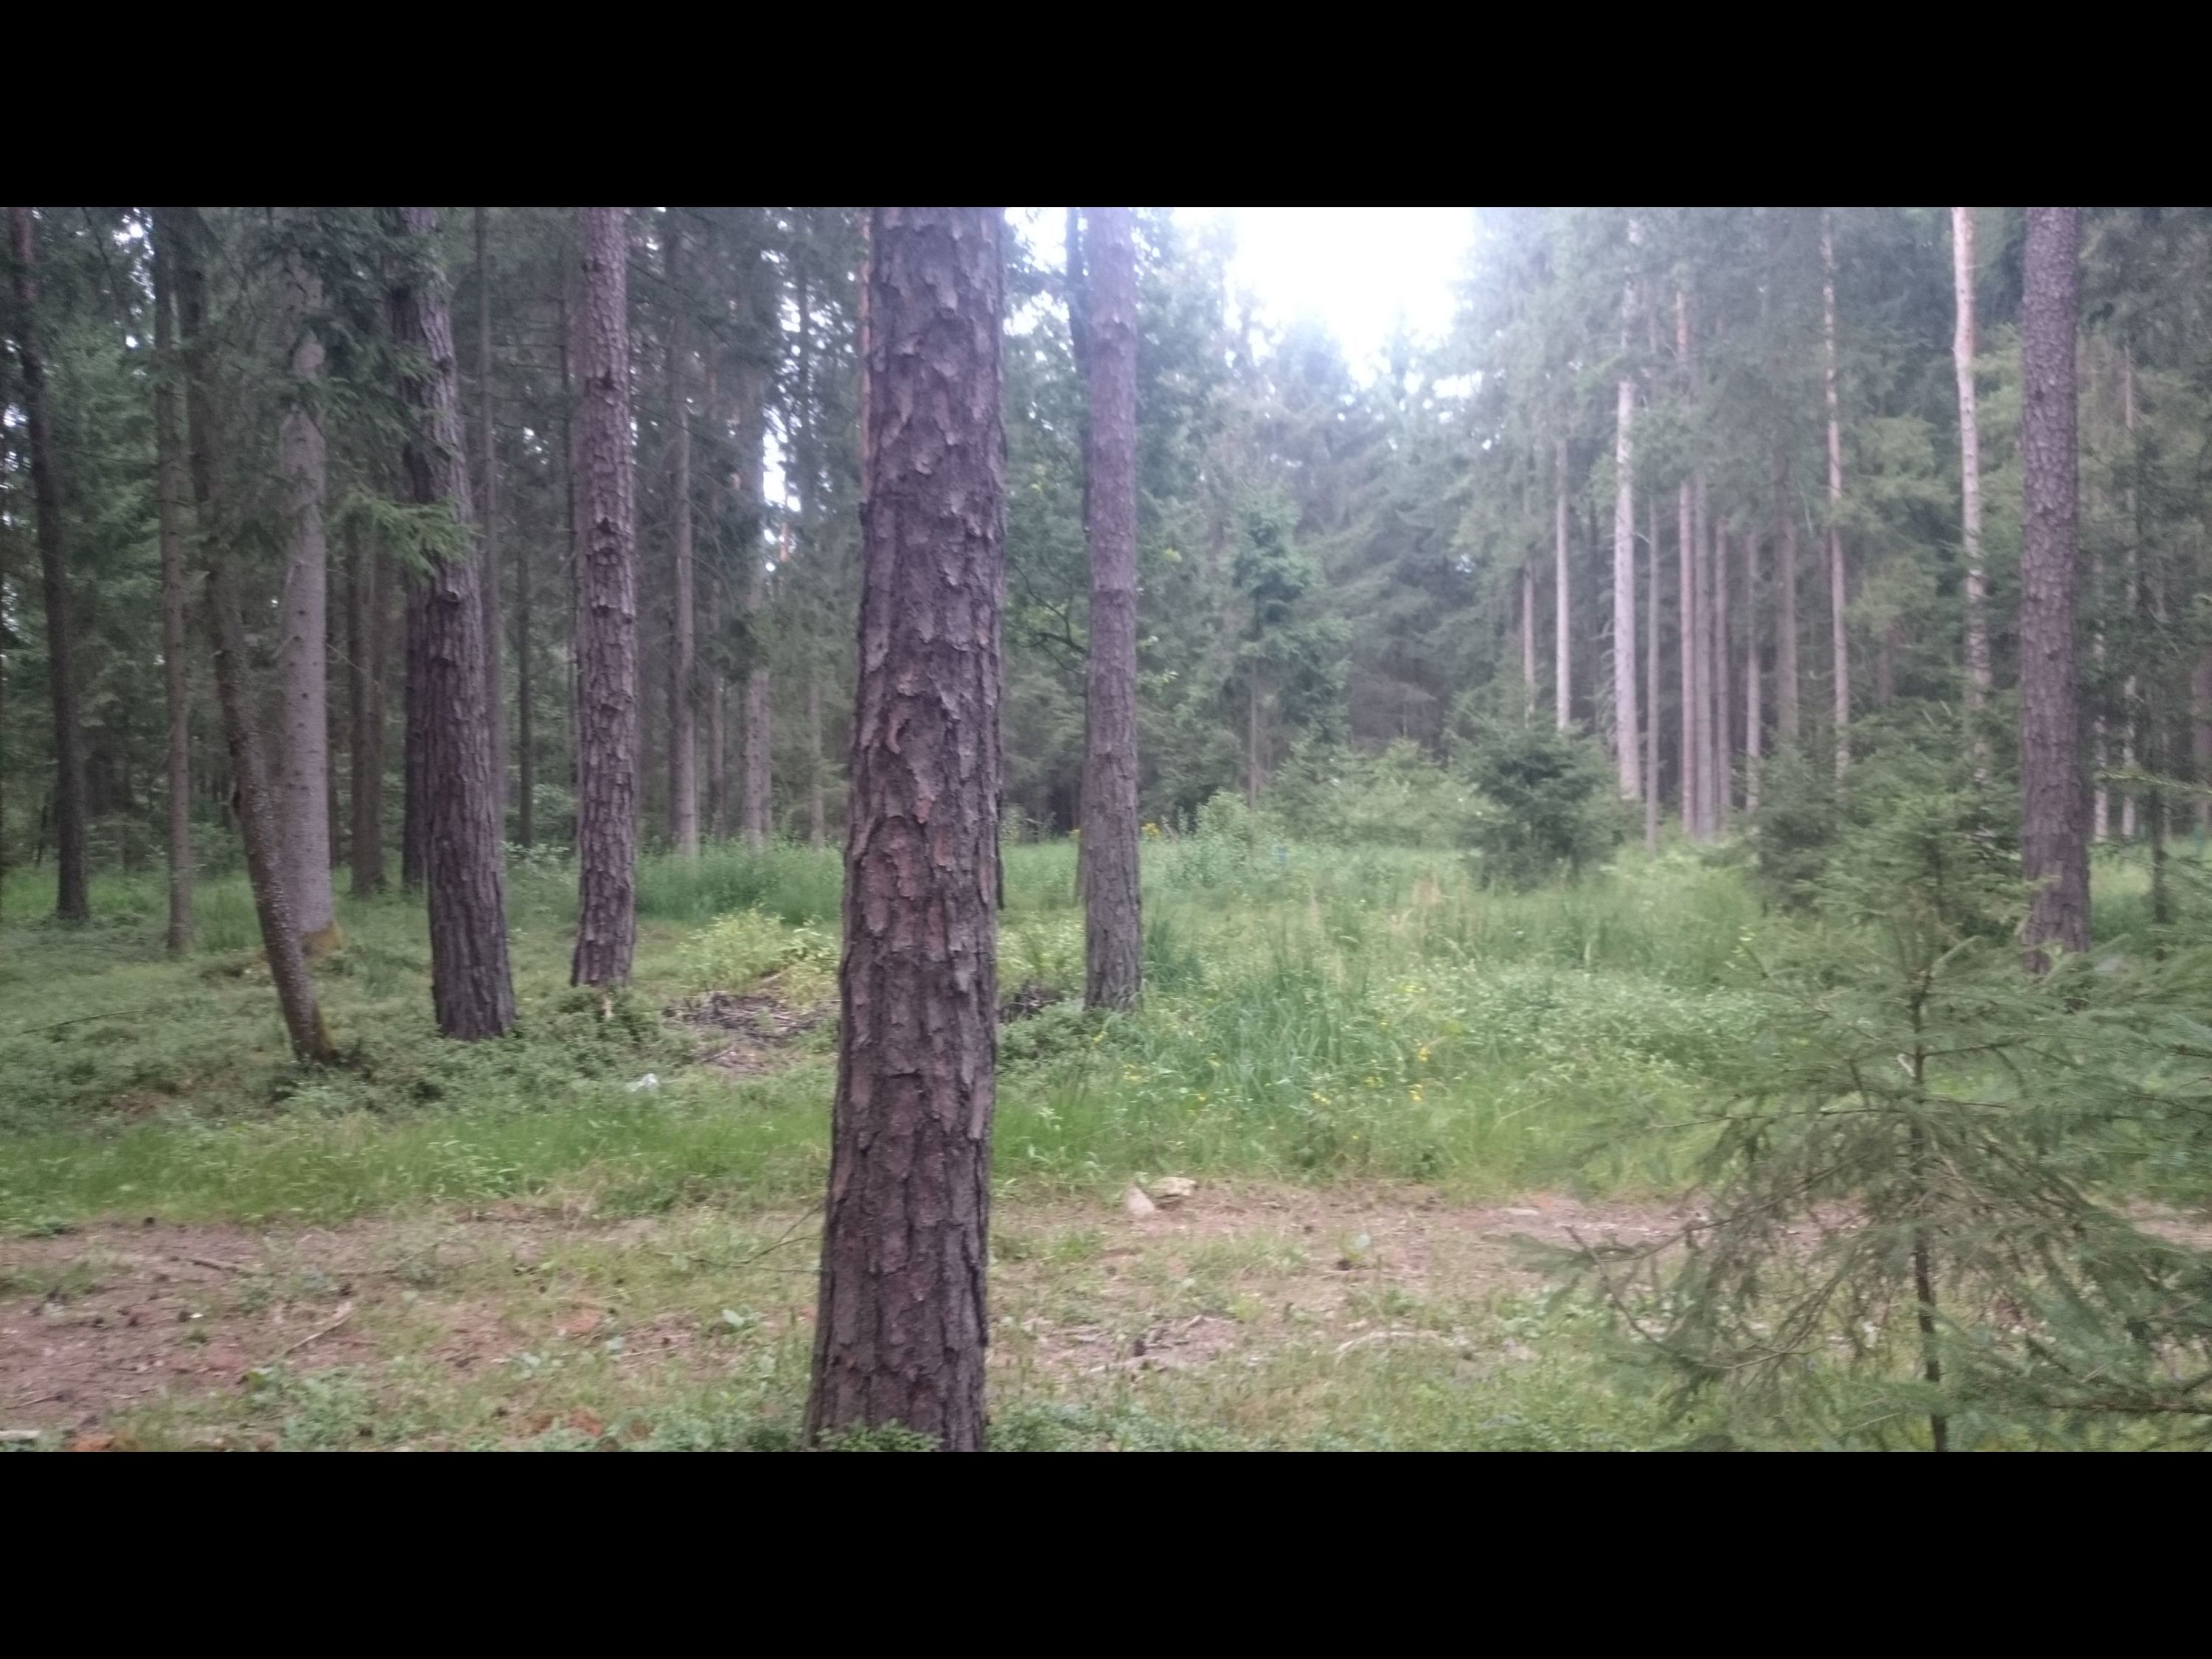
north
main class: Woodland
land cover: Pine dominated coniferous woodland
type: hemiboreal forest and nemoral coniferous forest and mixed broadleaved-coniferous forest
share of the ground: 50 - 75 %
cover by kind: coniferous forest trees 60 %, shrubs 30 %, unconsolidated bare surface 10 %
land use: Forestry
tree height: > 5 m
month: July
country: AT
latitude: 47.1038
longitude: 15.9966
